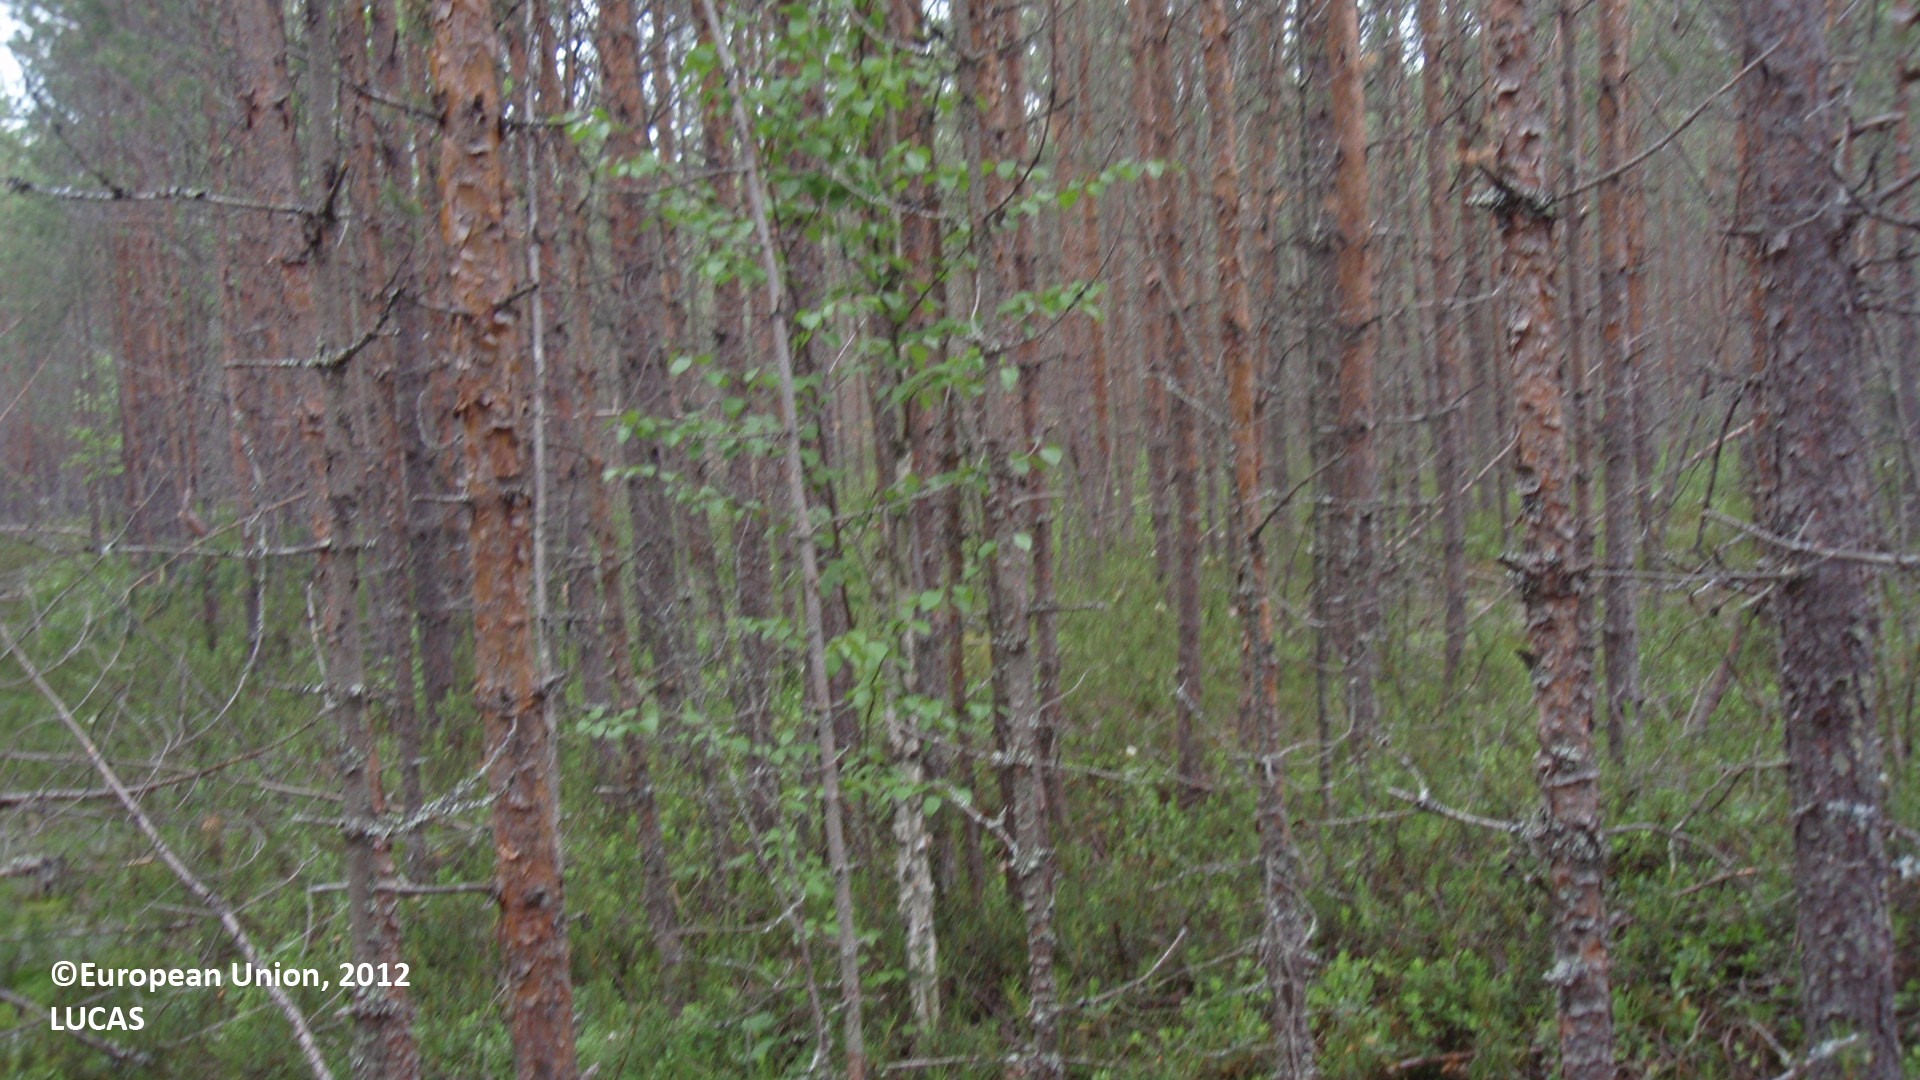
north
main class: Woodland
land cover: Pine dominated coniferous woodland
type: boreal forest
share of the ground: > 75 %
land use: Forestry
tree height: > 5 m
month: June
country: FI
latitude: 61.0891
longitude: 26.7542
